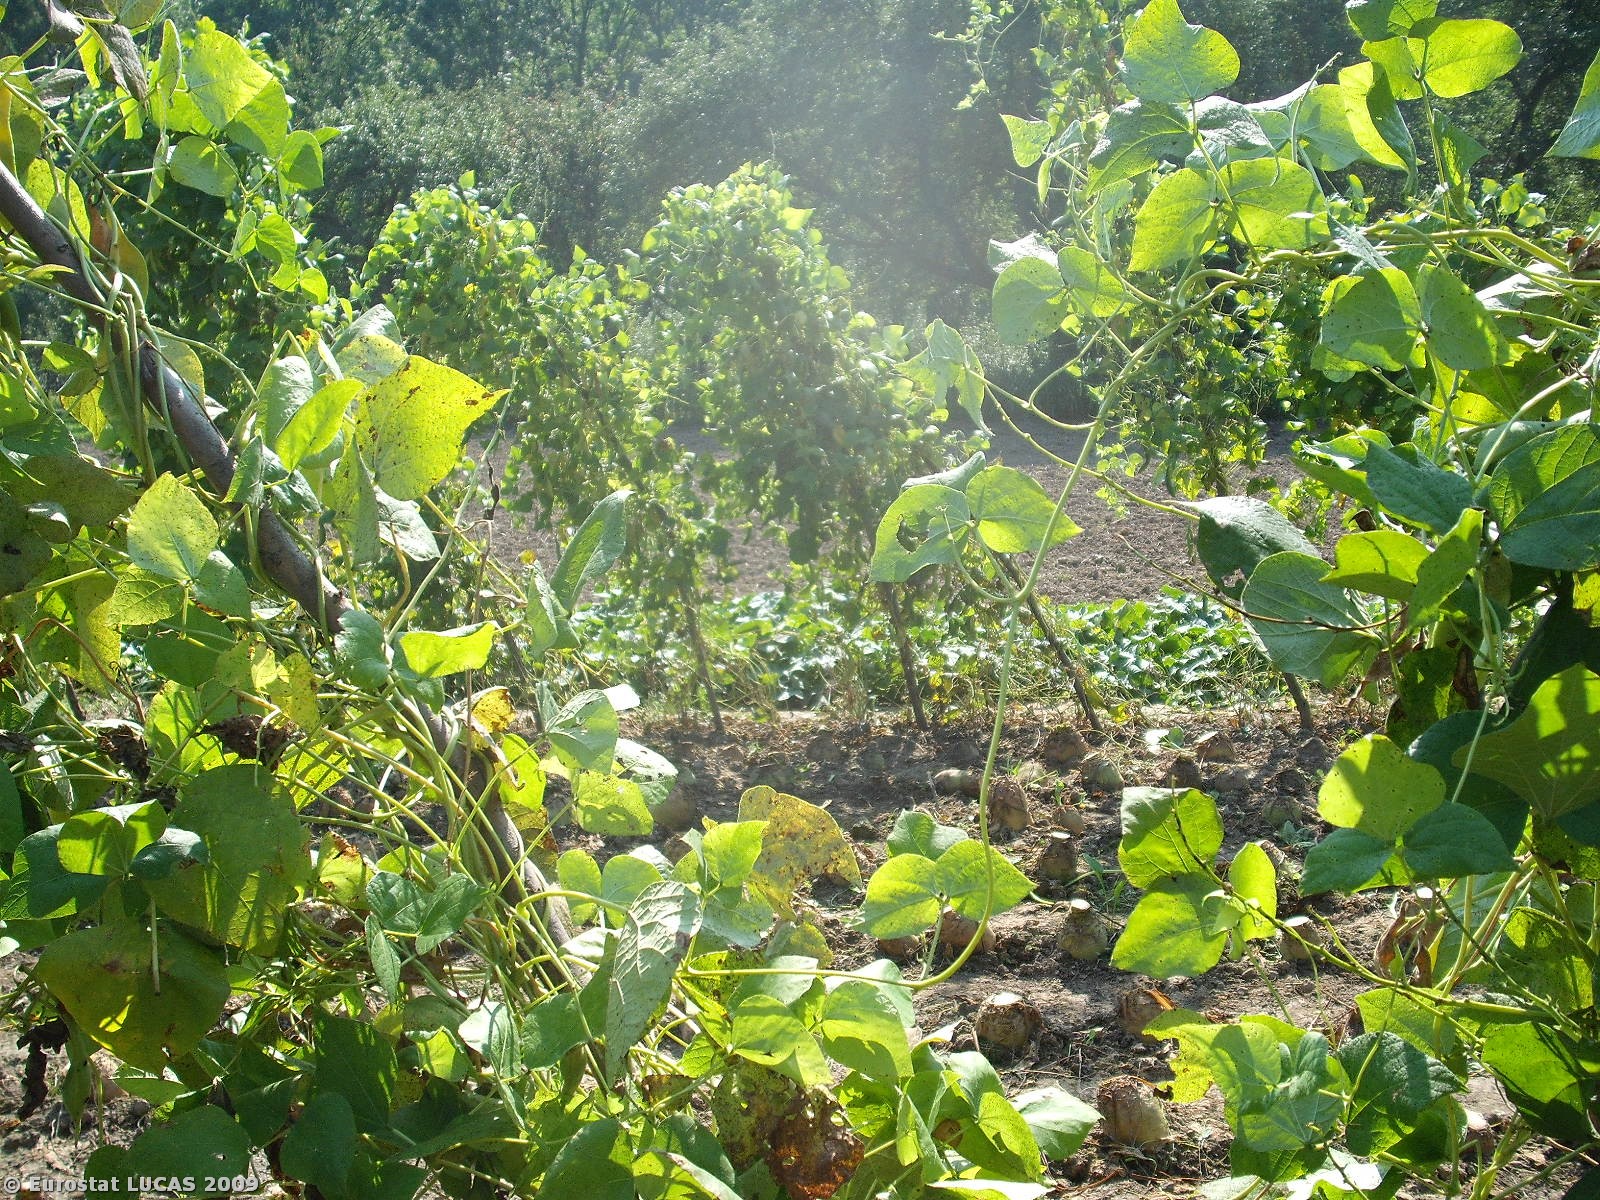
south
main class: Cropland
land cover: Dry pulses
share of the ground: 25 - 50 %
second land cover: Spontaneously vegetated surfaces
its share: 50 - 75 %
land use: Agriculture (excluding fallow land and kitchen gardens)
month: September
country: PL
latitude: 49.7483
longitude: 20.5438
